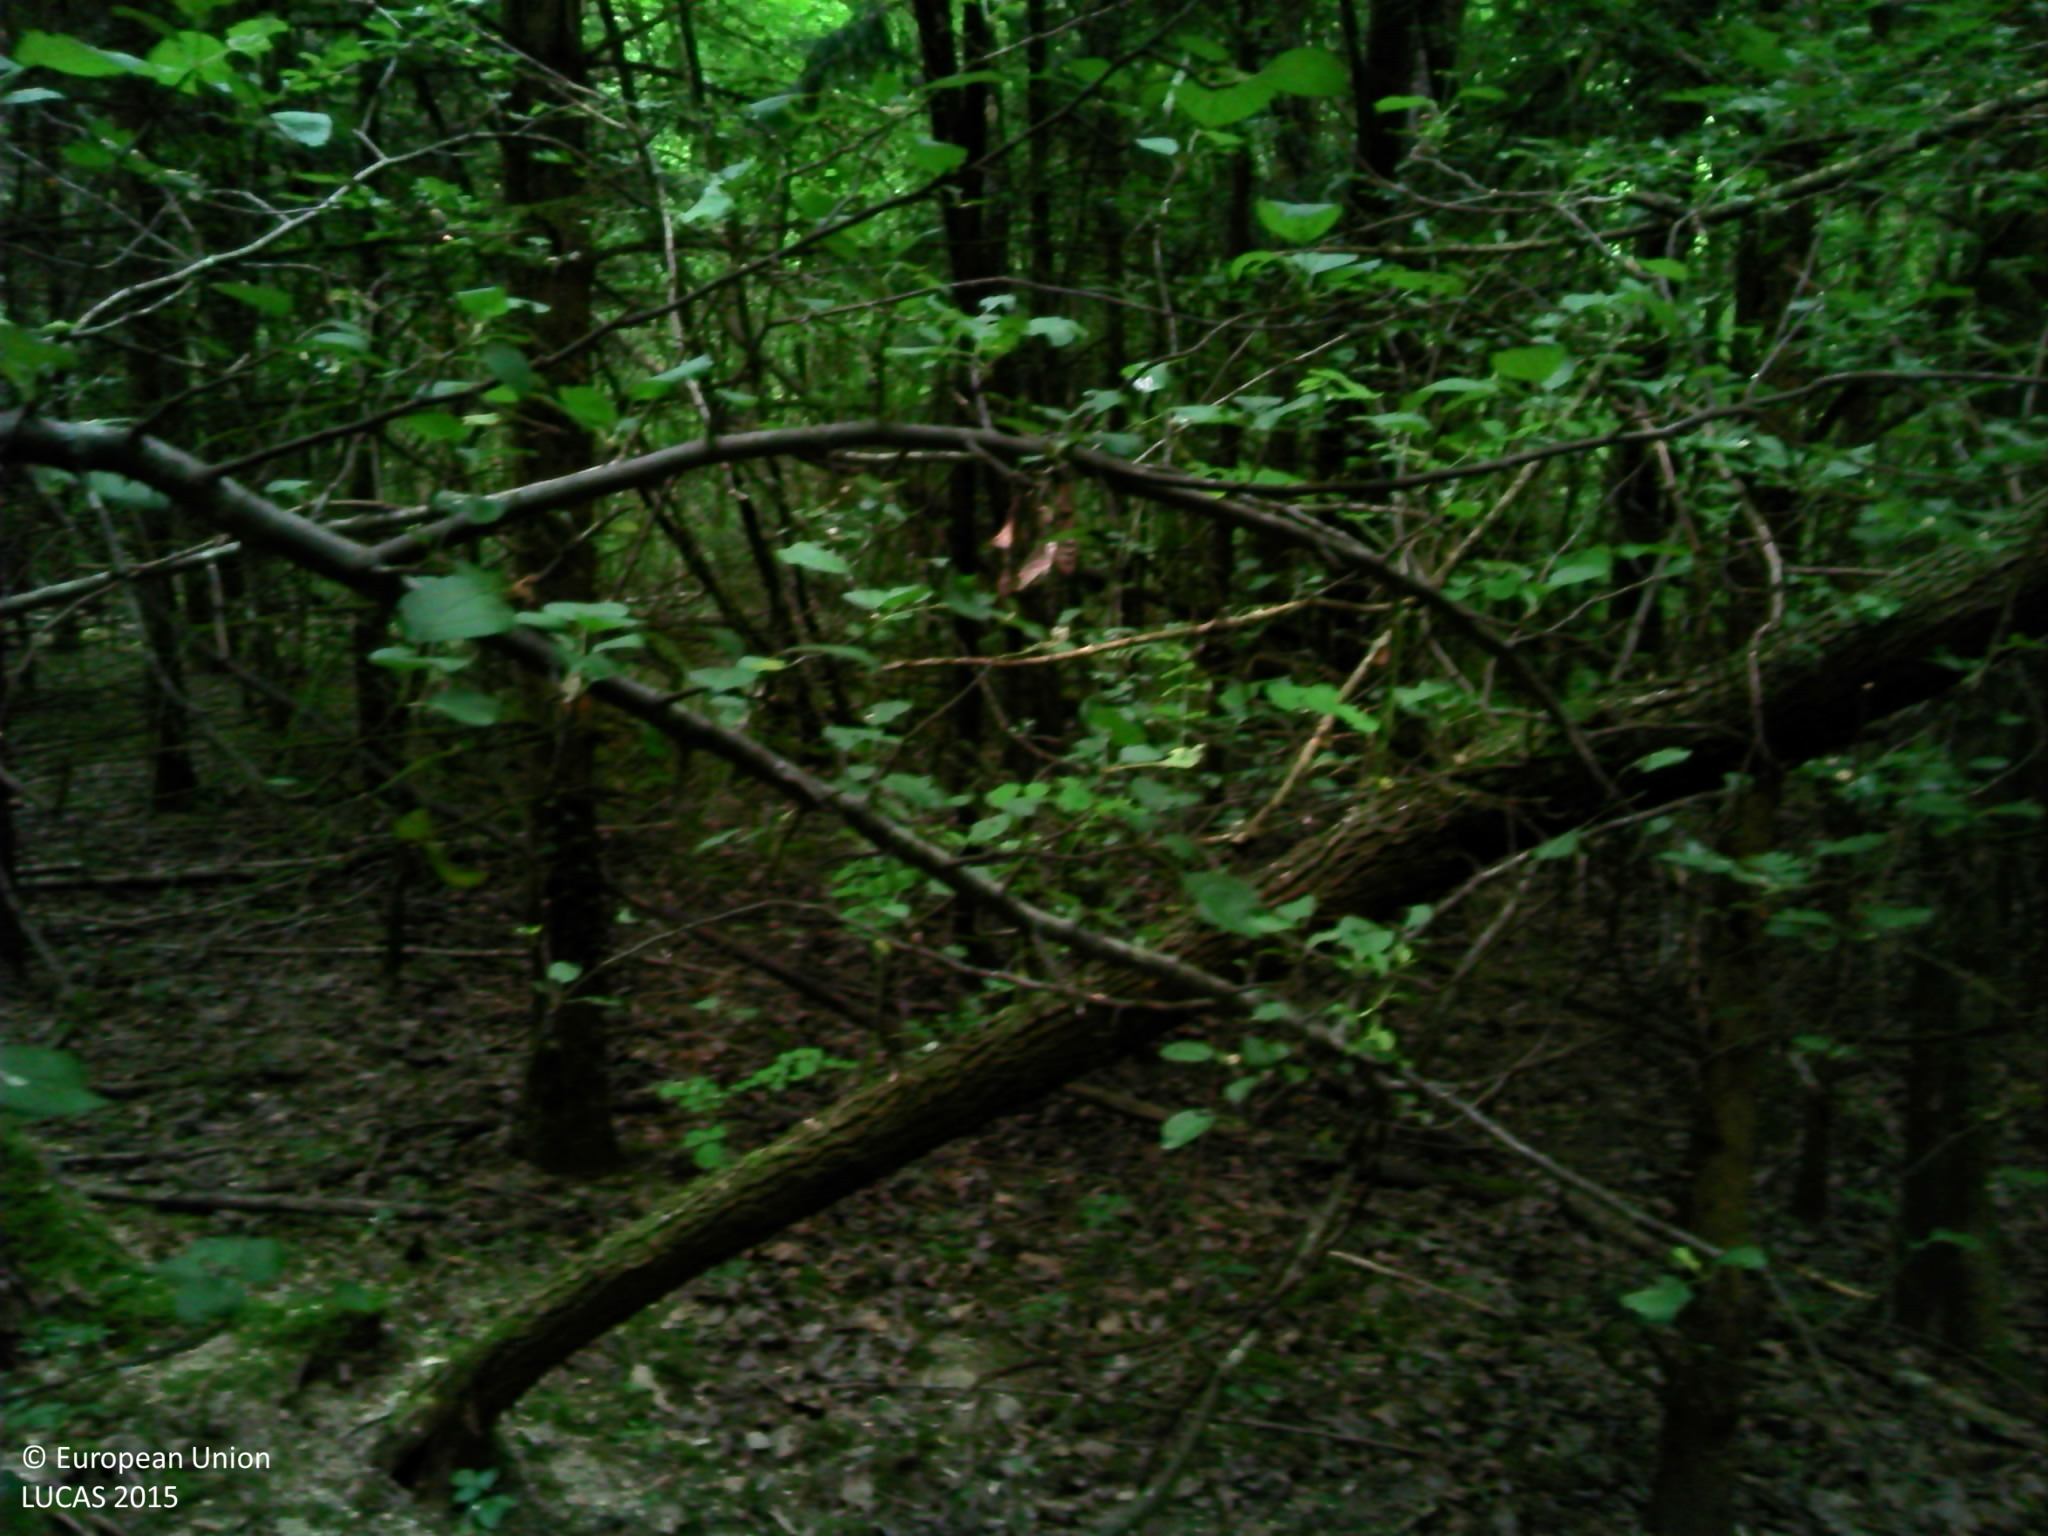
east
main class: Woodland
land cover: Spruce dominated mixed woodland
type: beech forest
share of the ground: > 75 %
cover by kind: coniferous forest trees 50 %, broadleaved forest trees 50 %
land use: Forestry
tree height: > 5 m
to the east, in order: Spruce dominated mixed woodland; Broadleaved woodland; Shrubland with sparse tree cover; Spruce dominated mixed woodland; Fences; Grassland without tree/shrub cover
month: June
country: FR
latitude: 47.7787
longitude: 6.1708
